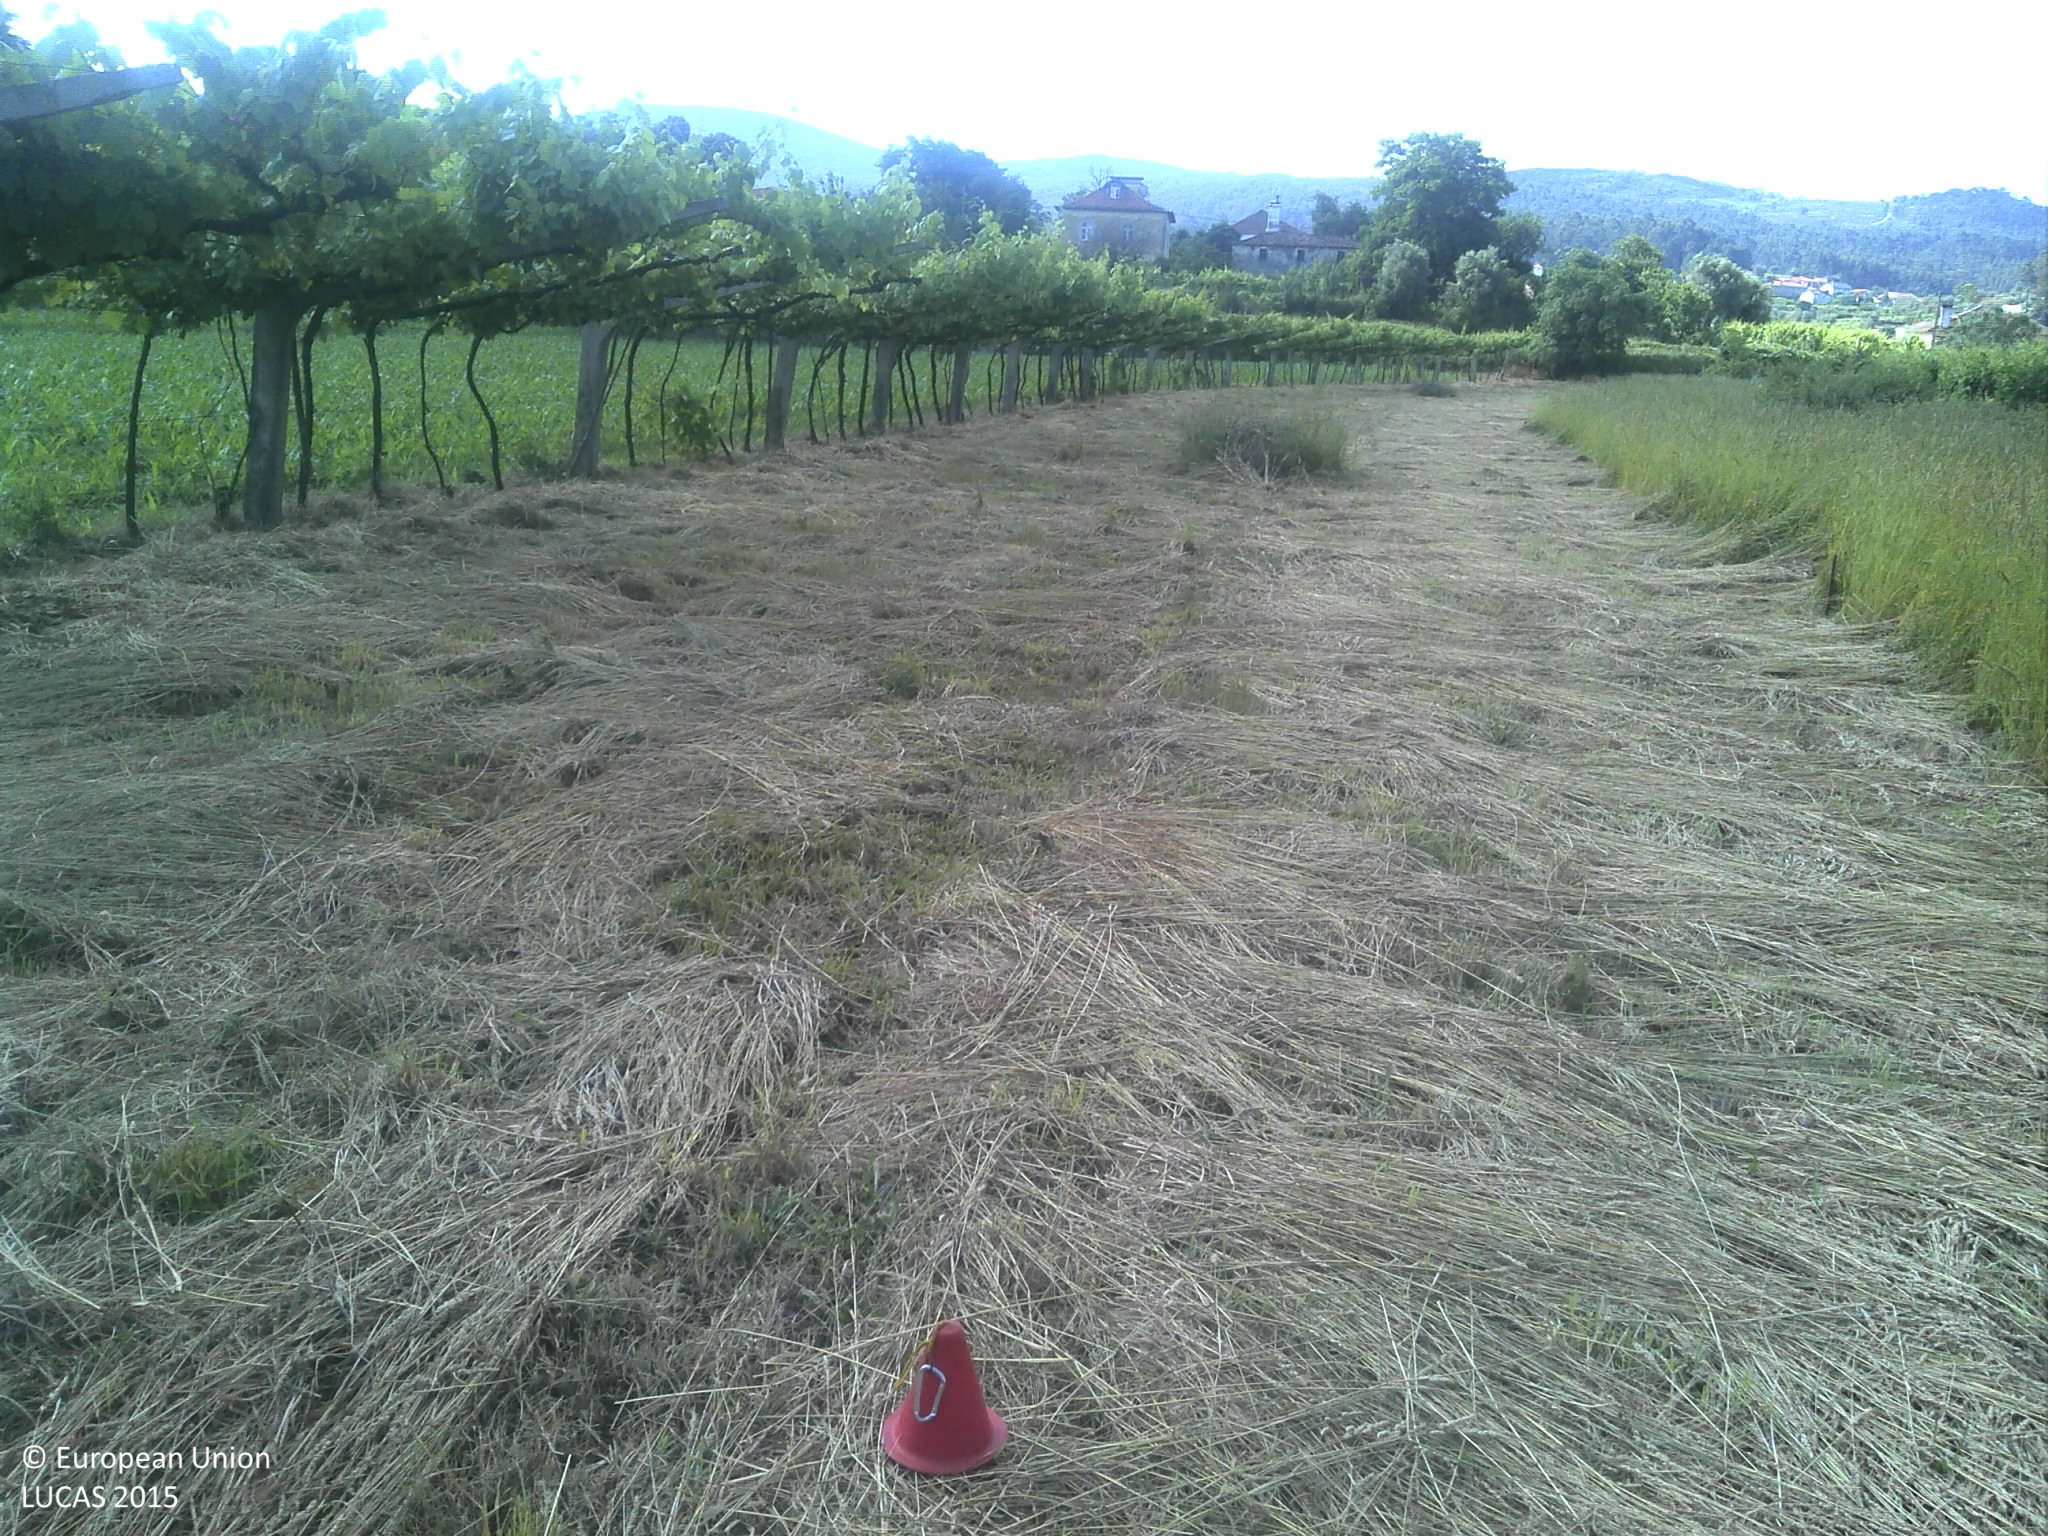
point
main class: Cropland
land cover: Temporary grasslands
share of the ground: 50 - 75 %
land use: Agriculture (excluding fallow land and kitchen gardens)
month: June
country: PT
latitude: 41.6142
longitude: -8.7042
